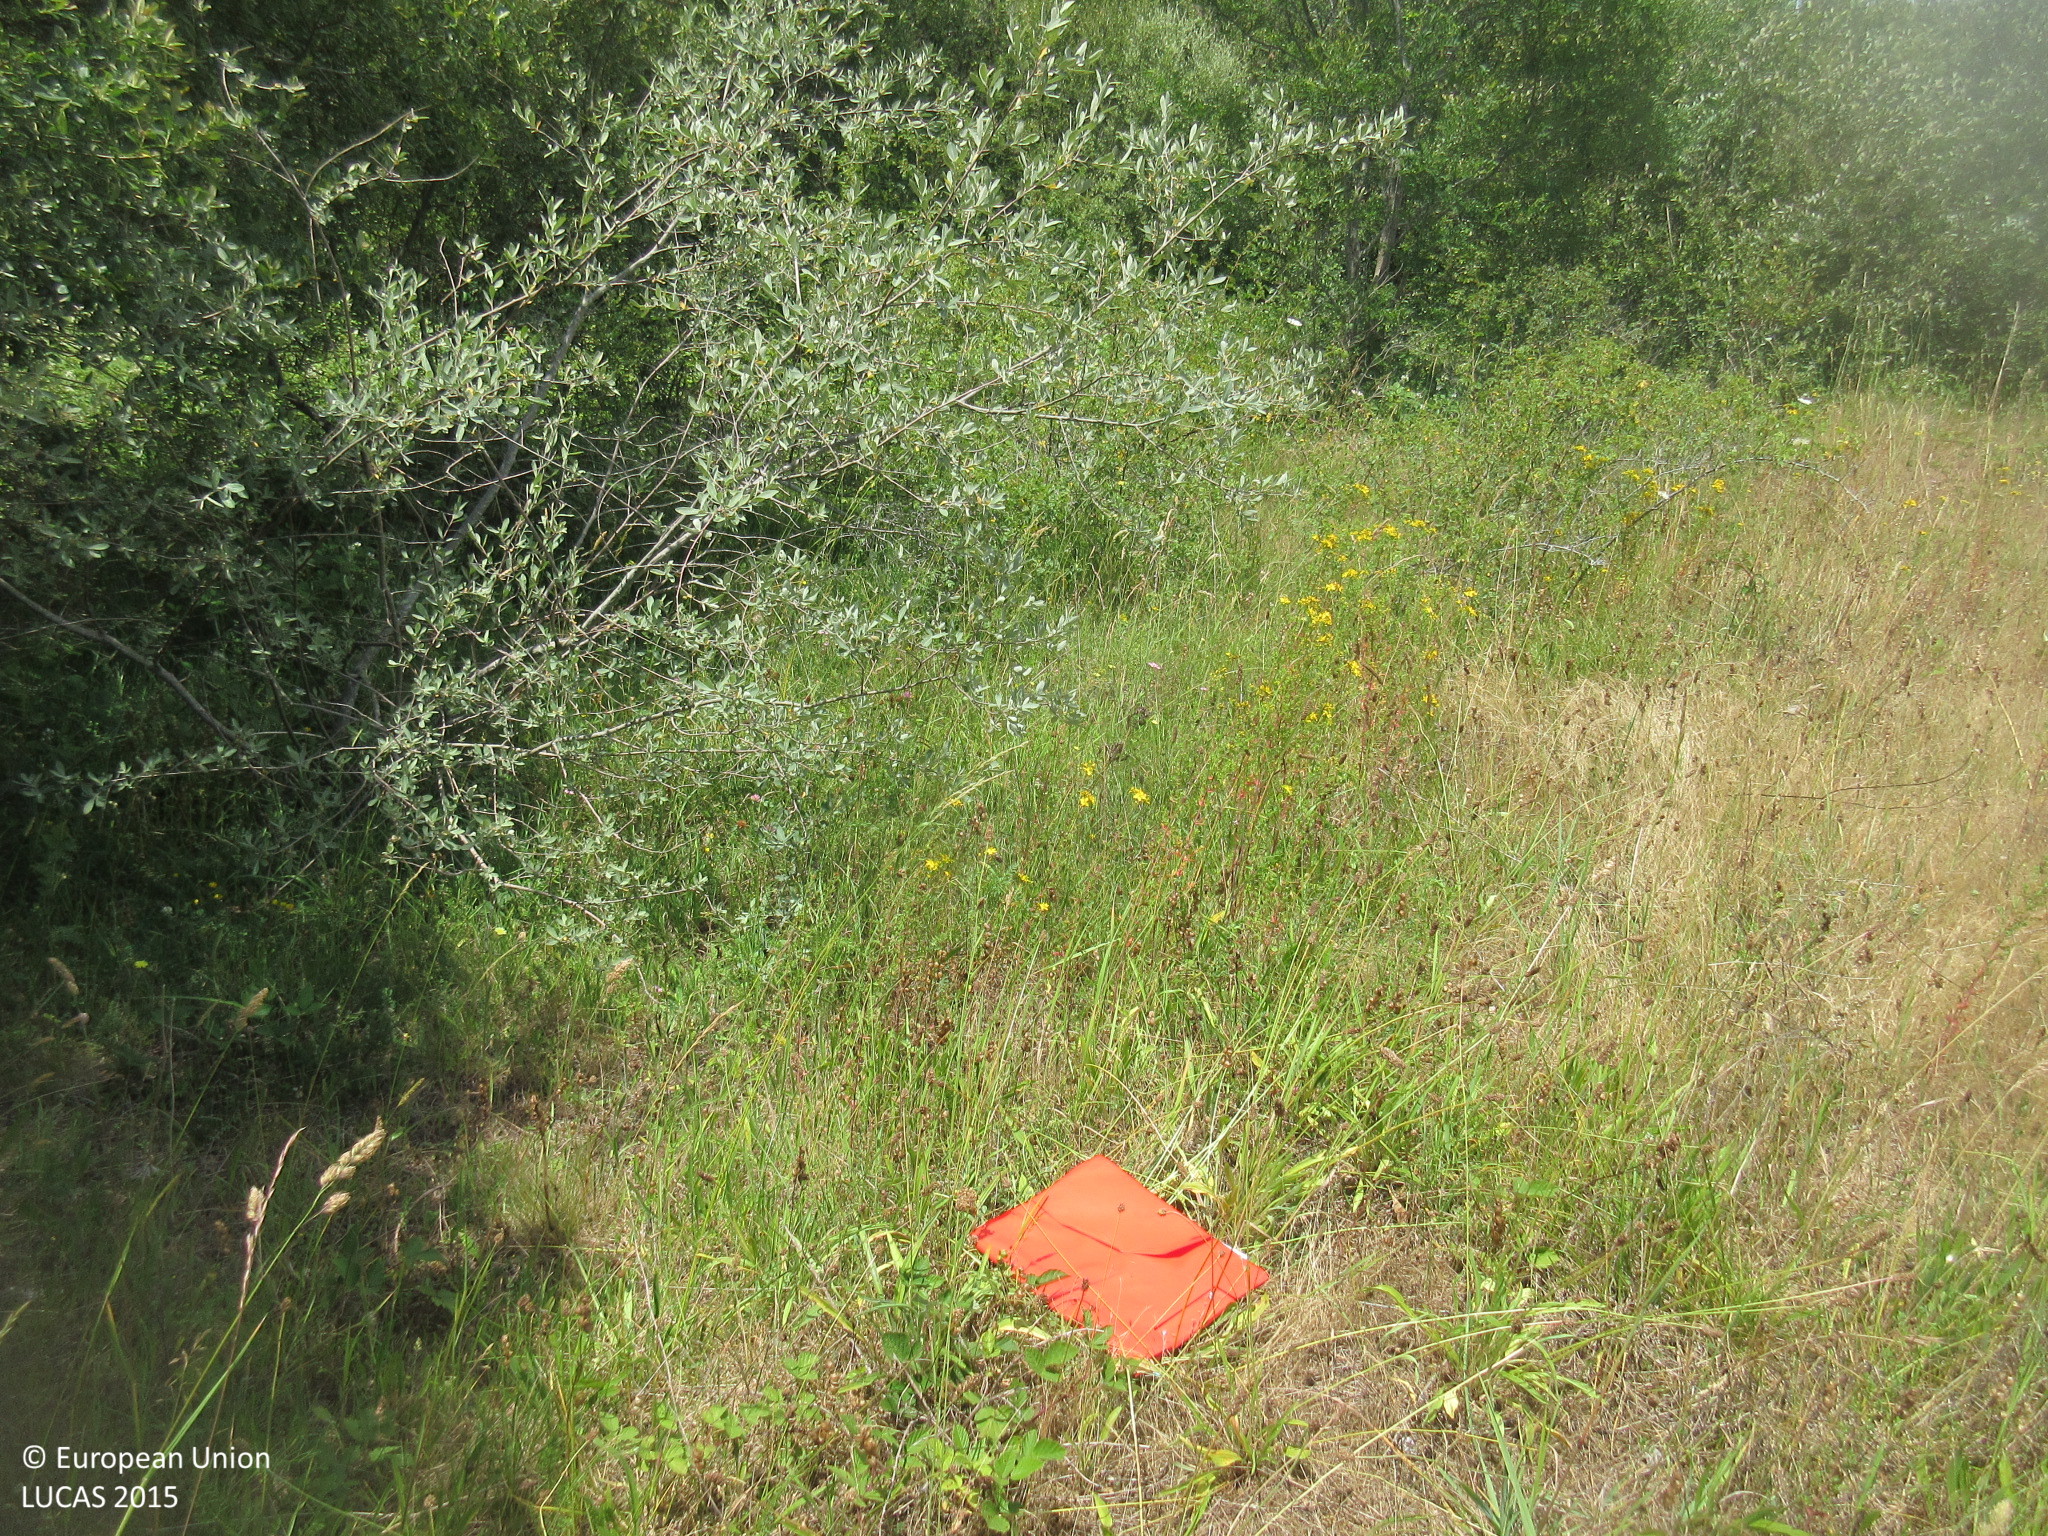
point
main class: Woodland
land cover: Broadleaved woodland
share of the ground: 50 - 75 %
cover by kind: broadleaved forest trees 70 %, shrubs 30 %
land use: Semi-natural and natural areas not in use
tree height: < 5 m
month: July
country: ES
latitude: 43.0012
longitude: -3.9454
